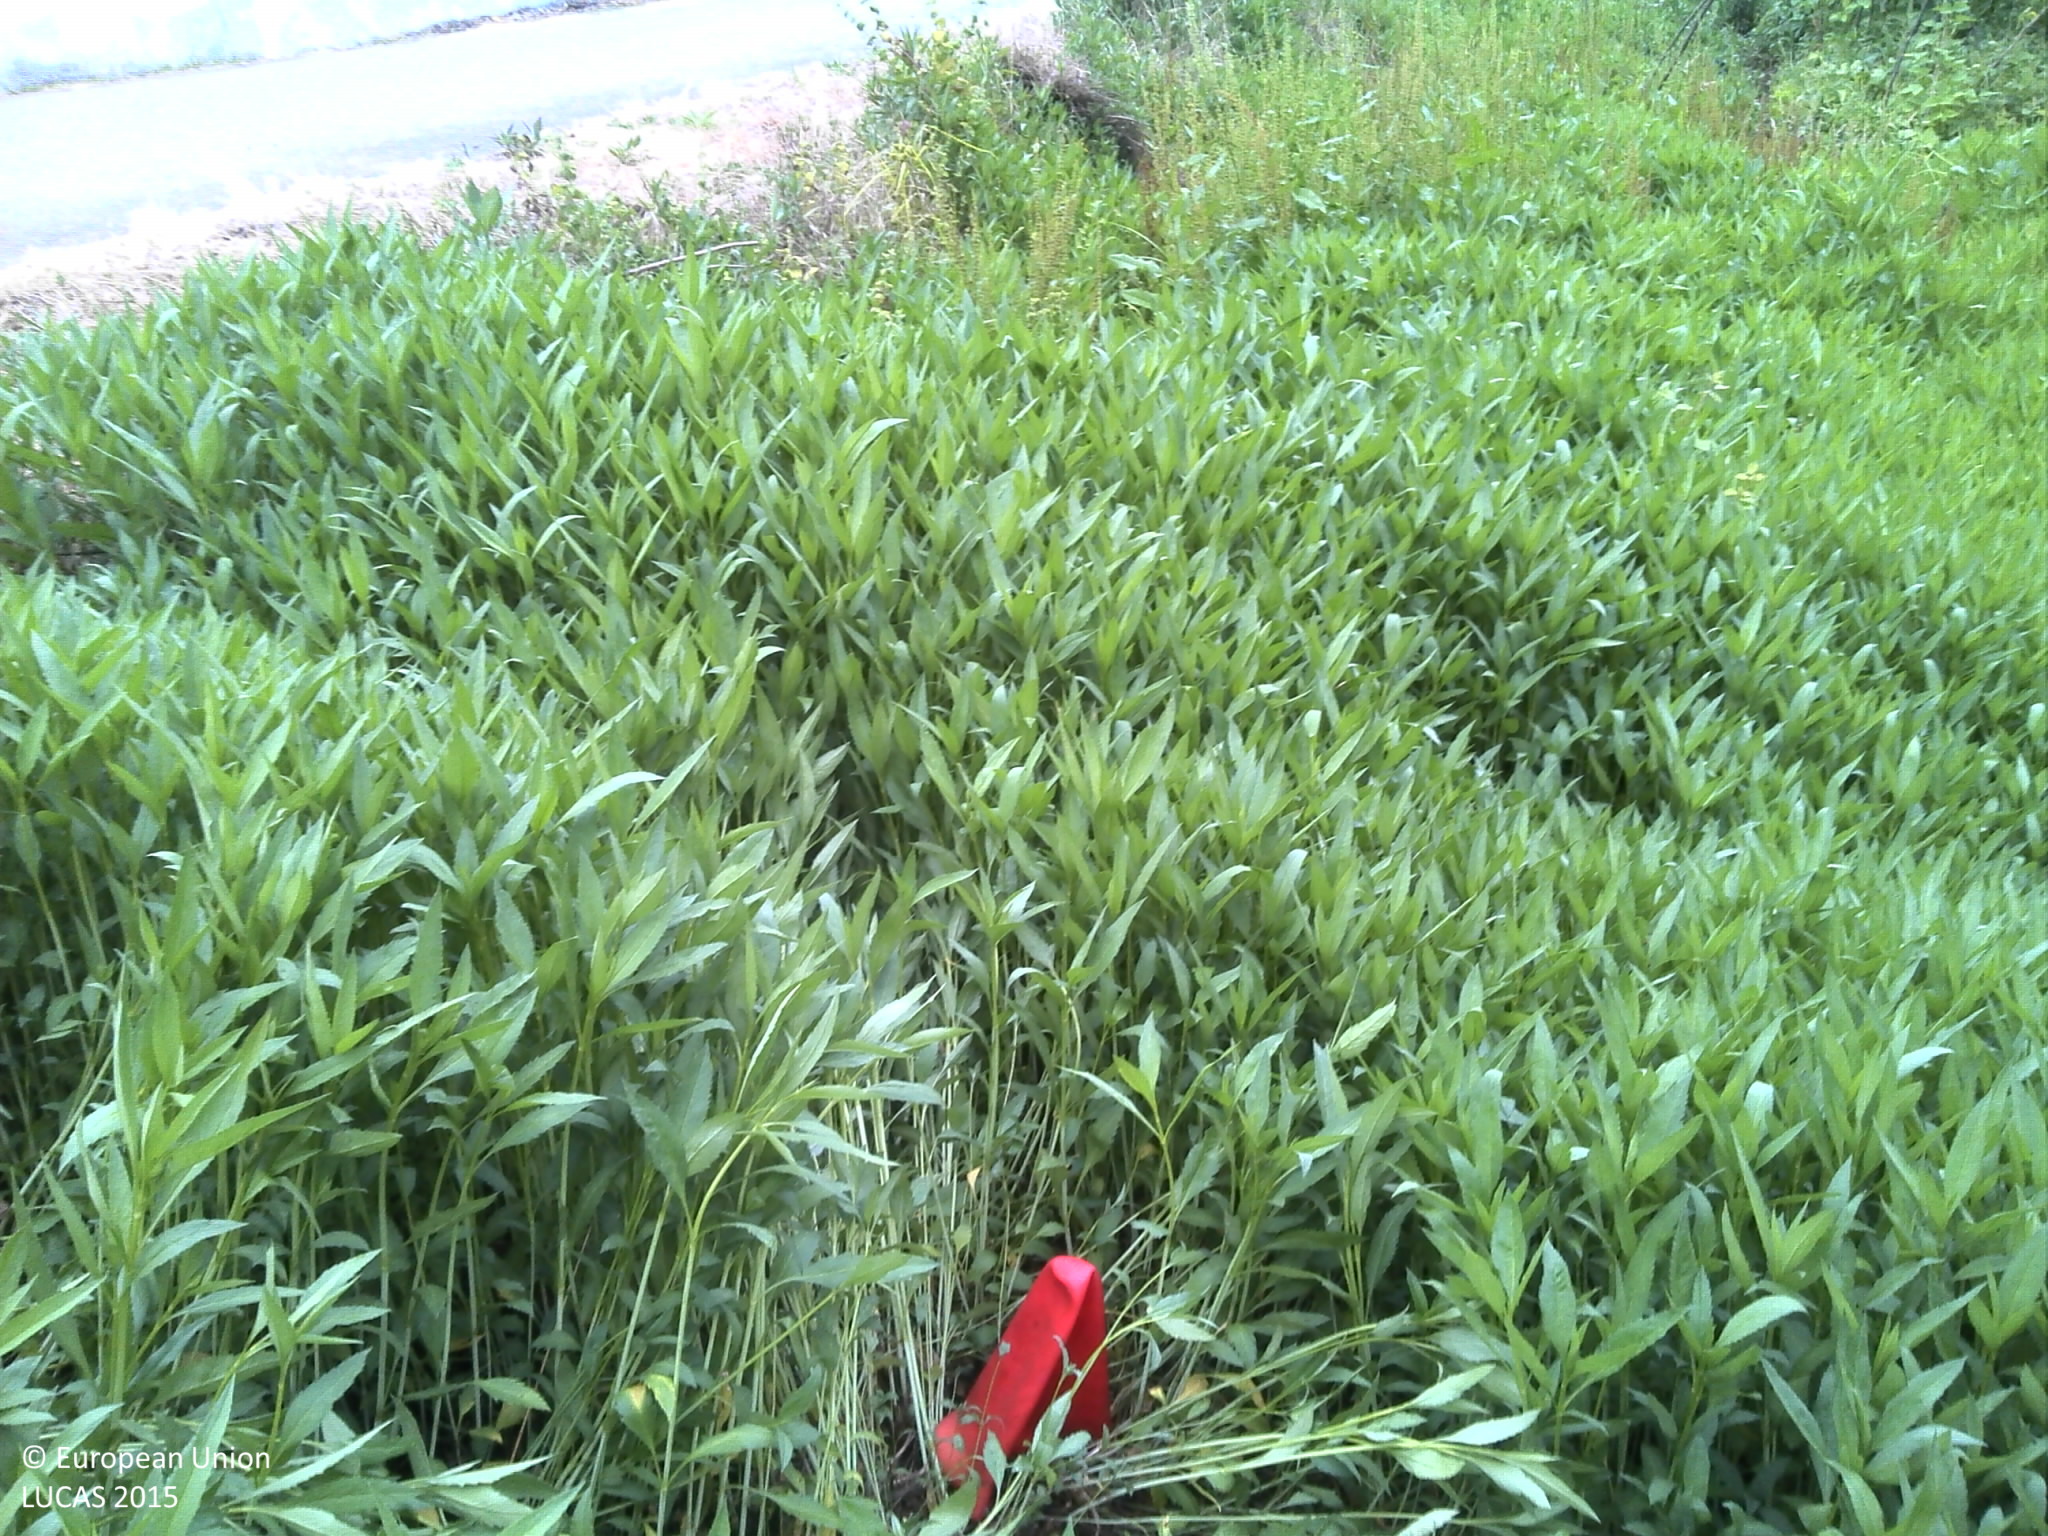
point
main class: Grassland
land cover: Grassland without tree/shrub cover
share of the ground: > 75 %
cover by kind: herbaceous plants 75 %, consolidated bare surface 15 %, unconsolidated bare surface 10 %
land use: Agriculture (excluding fallow land and kitchen gardens)
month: July
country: PT
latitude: 40.3820
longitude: -8.2813
